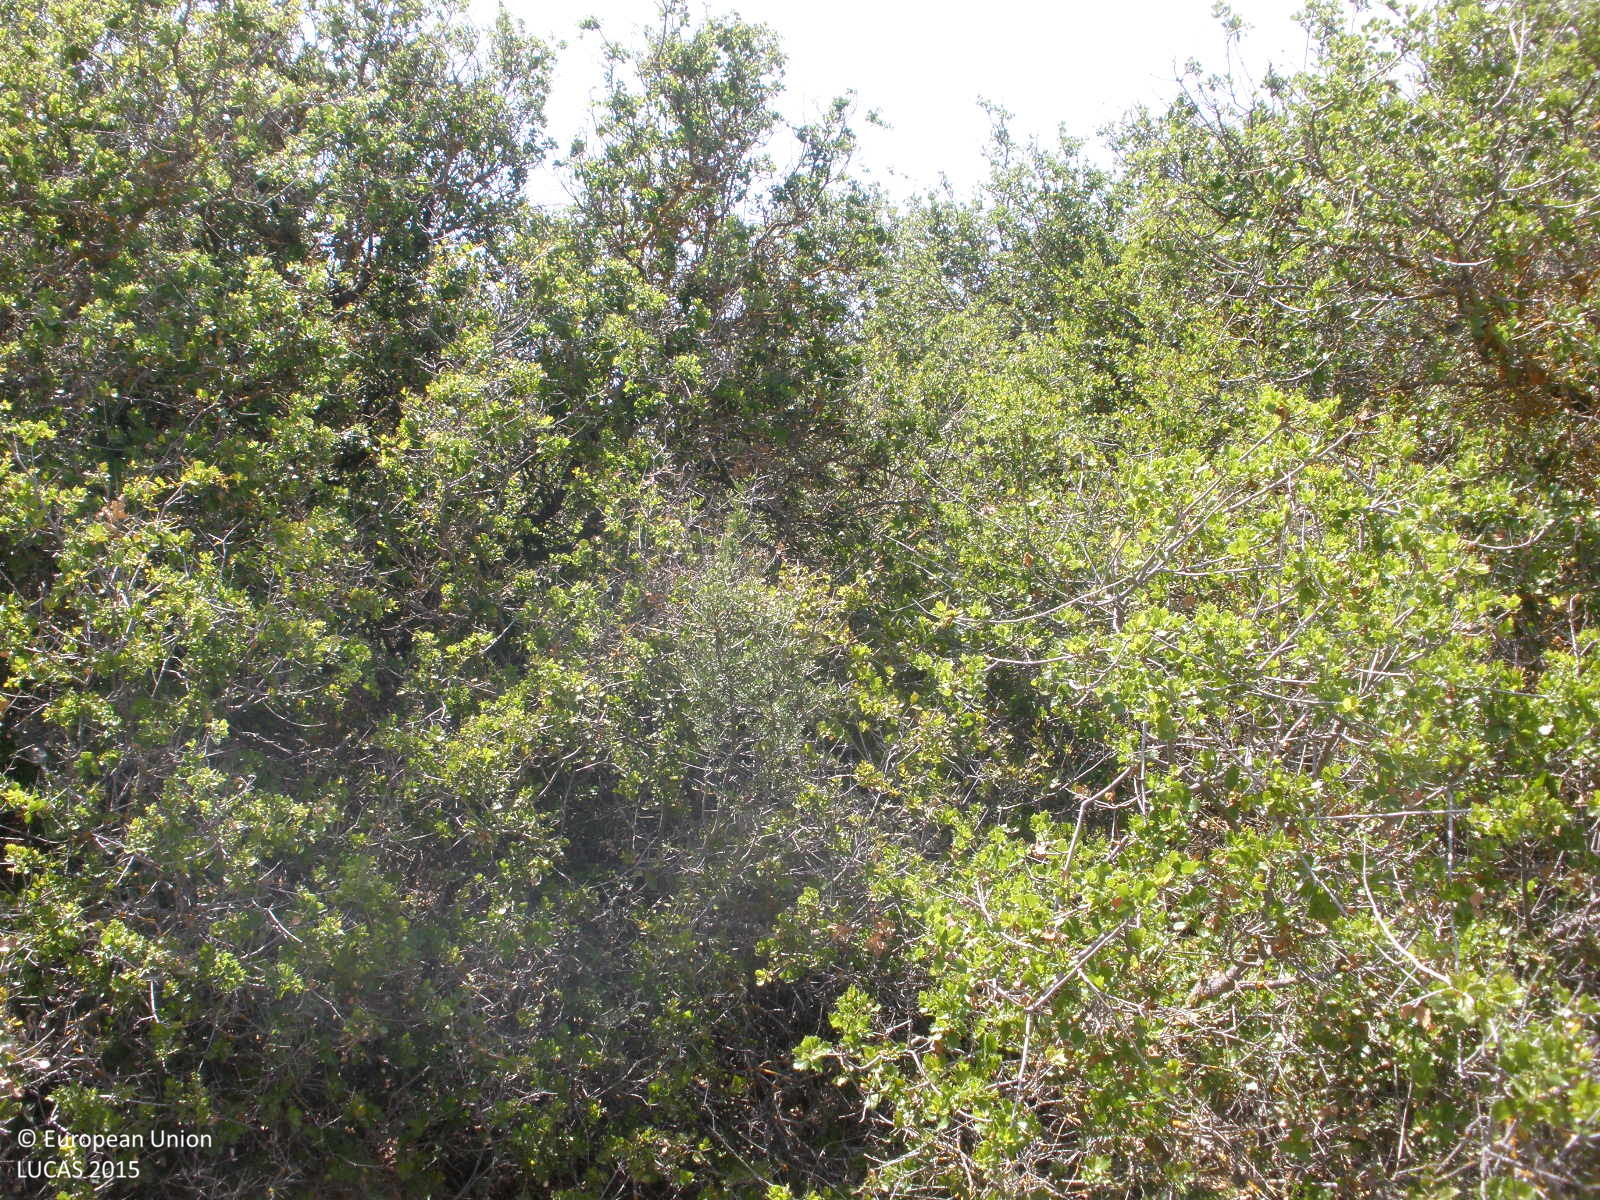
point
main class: Woodland
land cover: Broadleaved woodland
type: broadleaved evergreen forest
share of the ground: > 75 %
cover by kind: broadleaved forest trees 80 %, shrubs 20 %
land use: Semi-natural and natural areas not in use
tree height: < 5 m
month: July
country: ES
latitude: 40.2640
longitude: -3.4965
